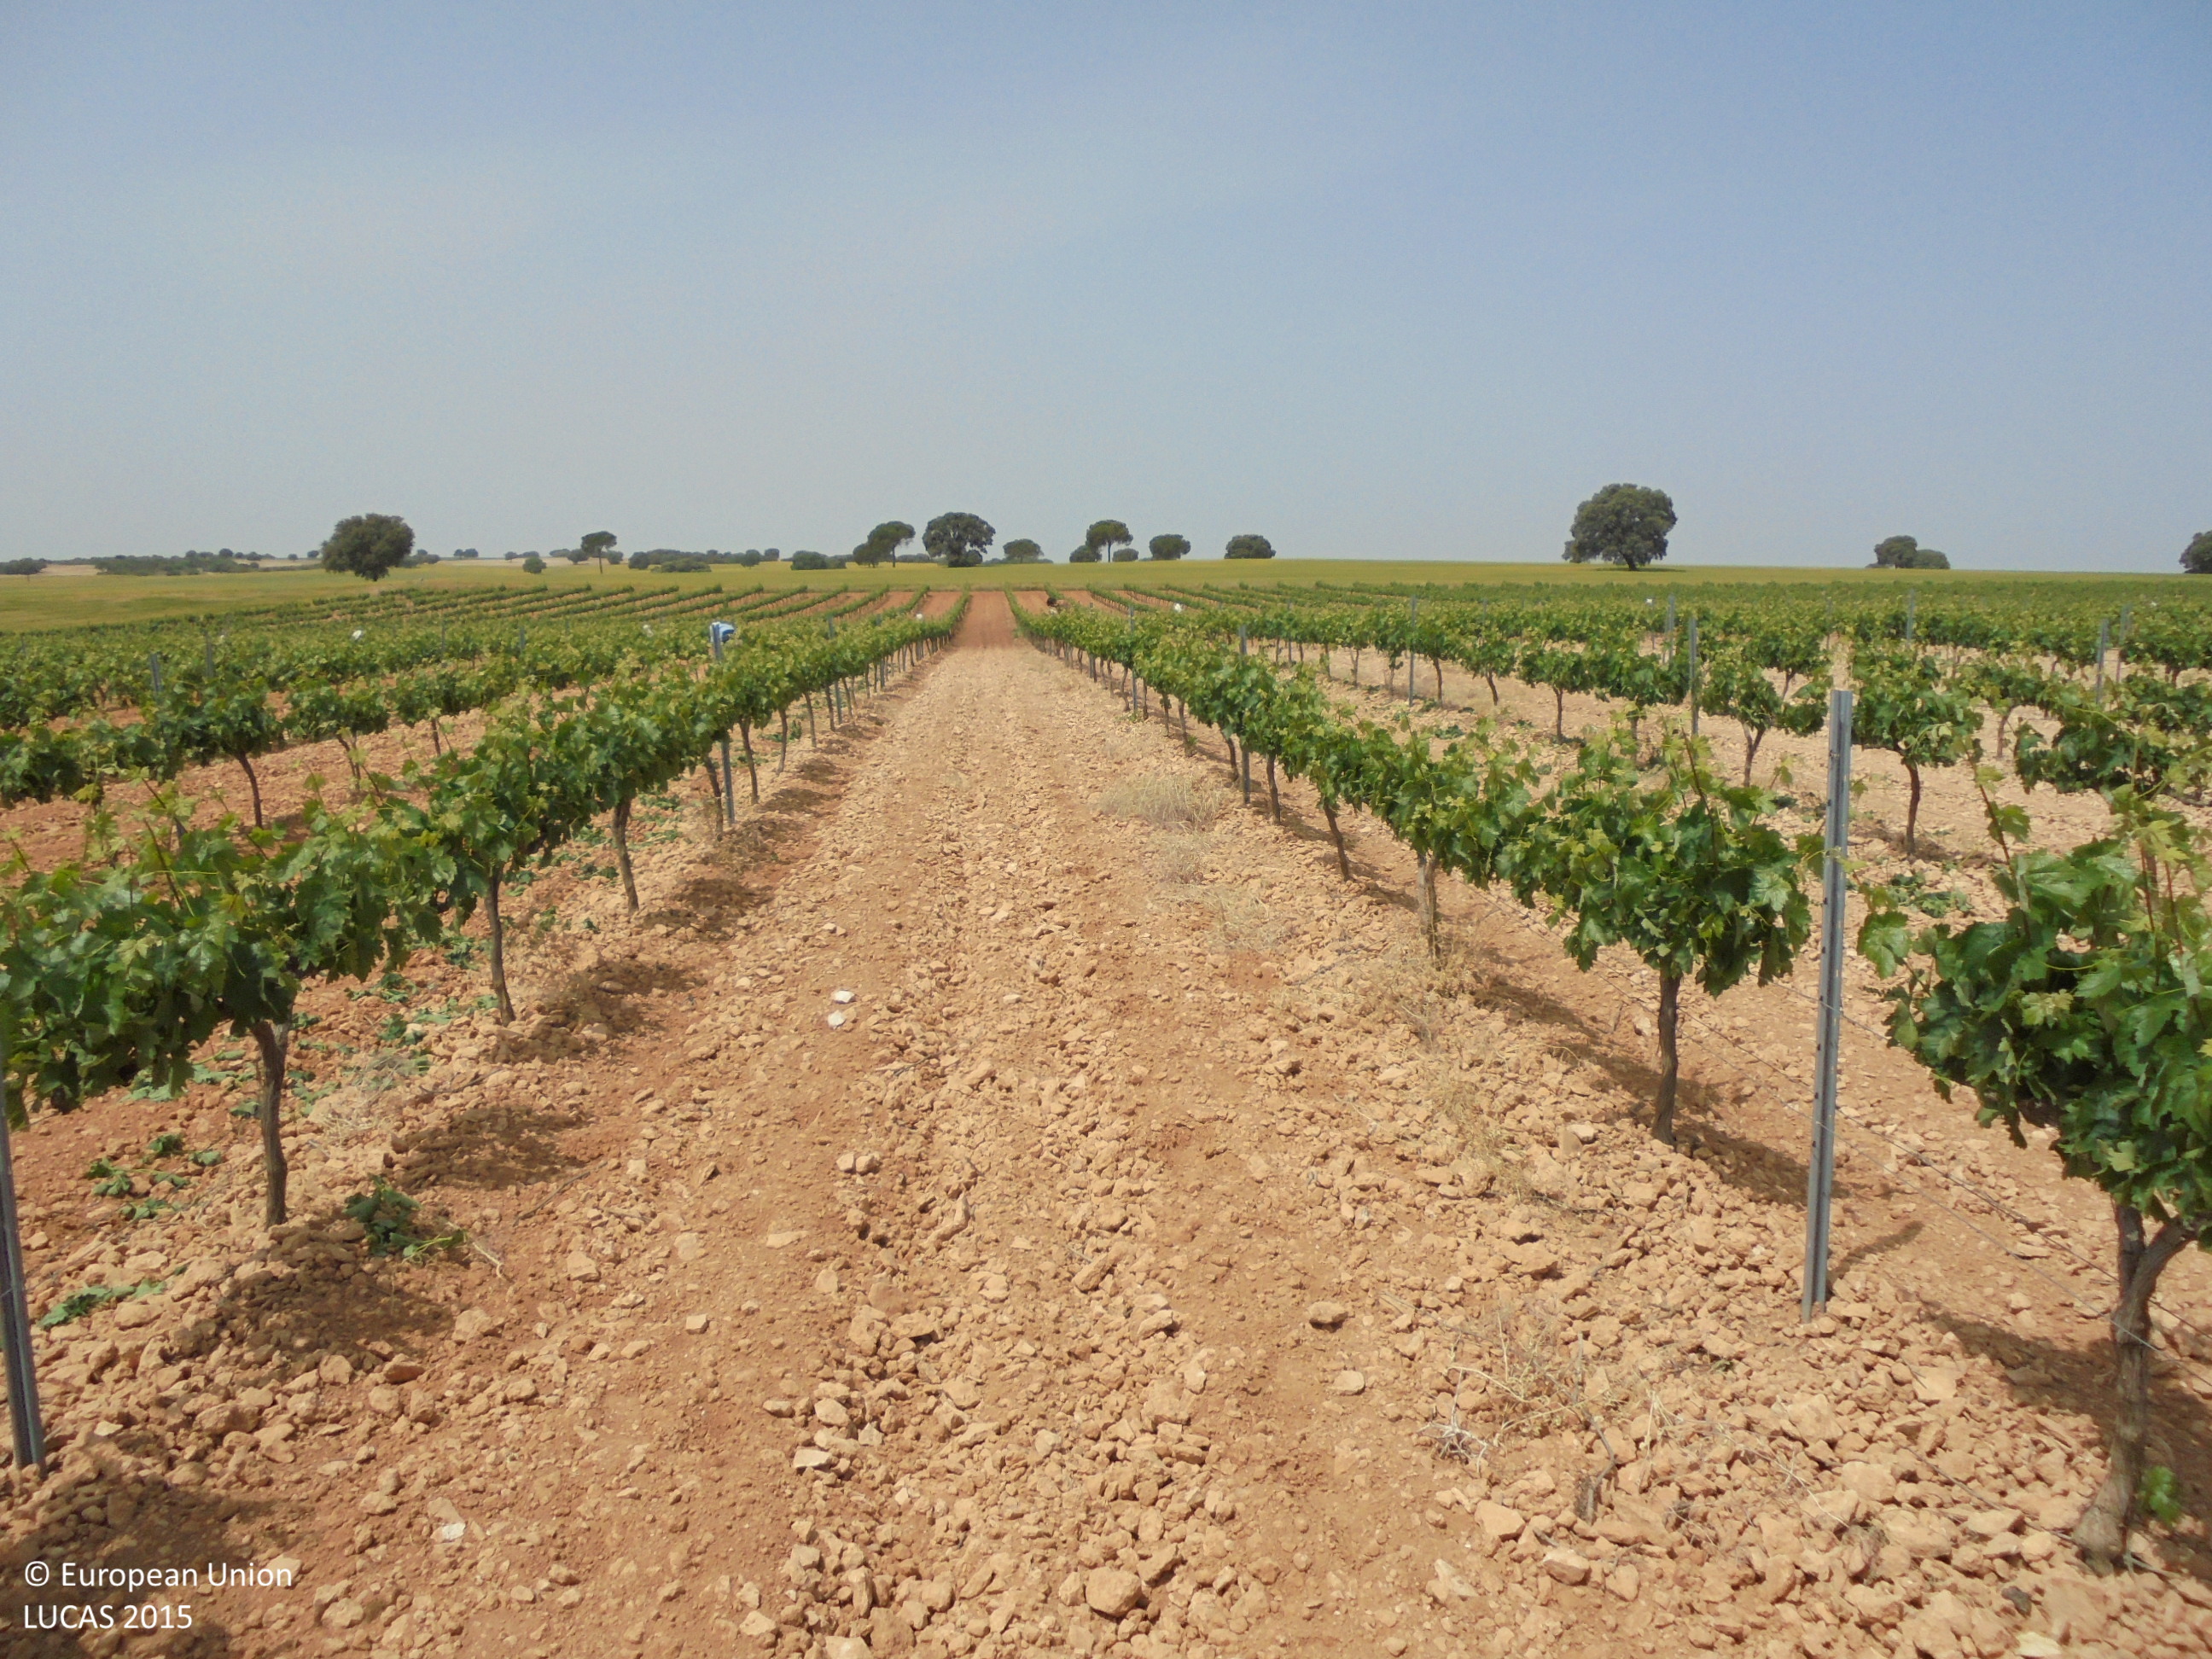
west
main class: Cropland
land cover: Vineyards
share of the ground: 10 - 25 %
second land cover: Other bare soil
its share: > 75 %
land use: Agriculture (excluding fallow land and kitchen gardens)
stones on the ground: > 50 %
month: May
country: ES
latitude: 39.0910
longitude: -1.6891
